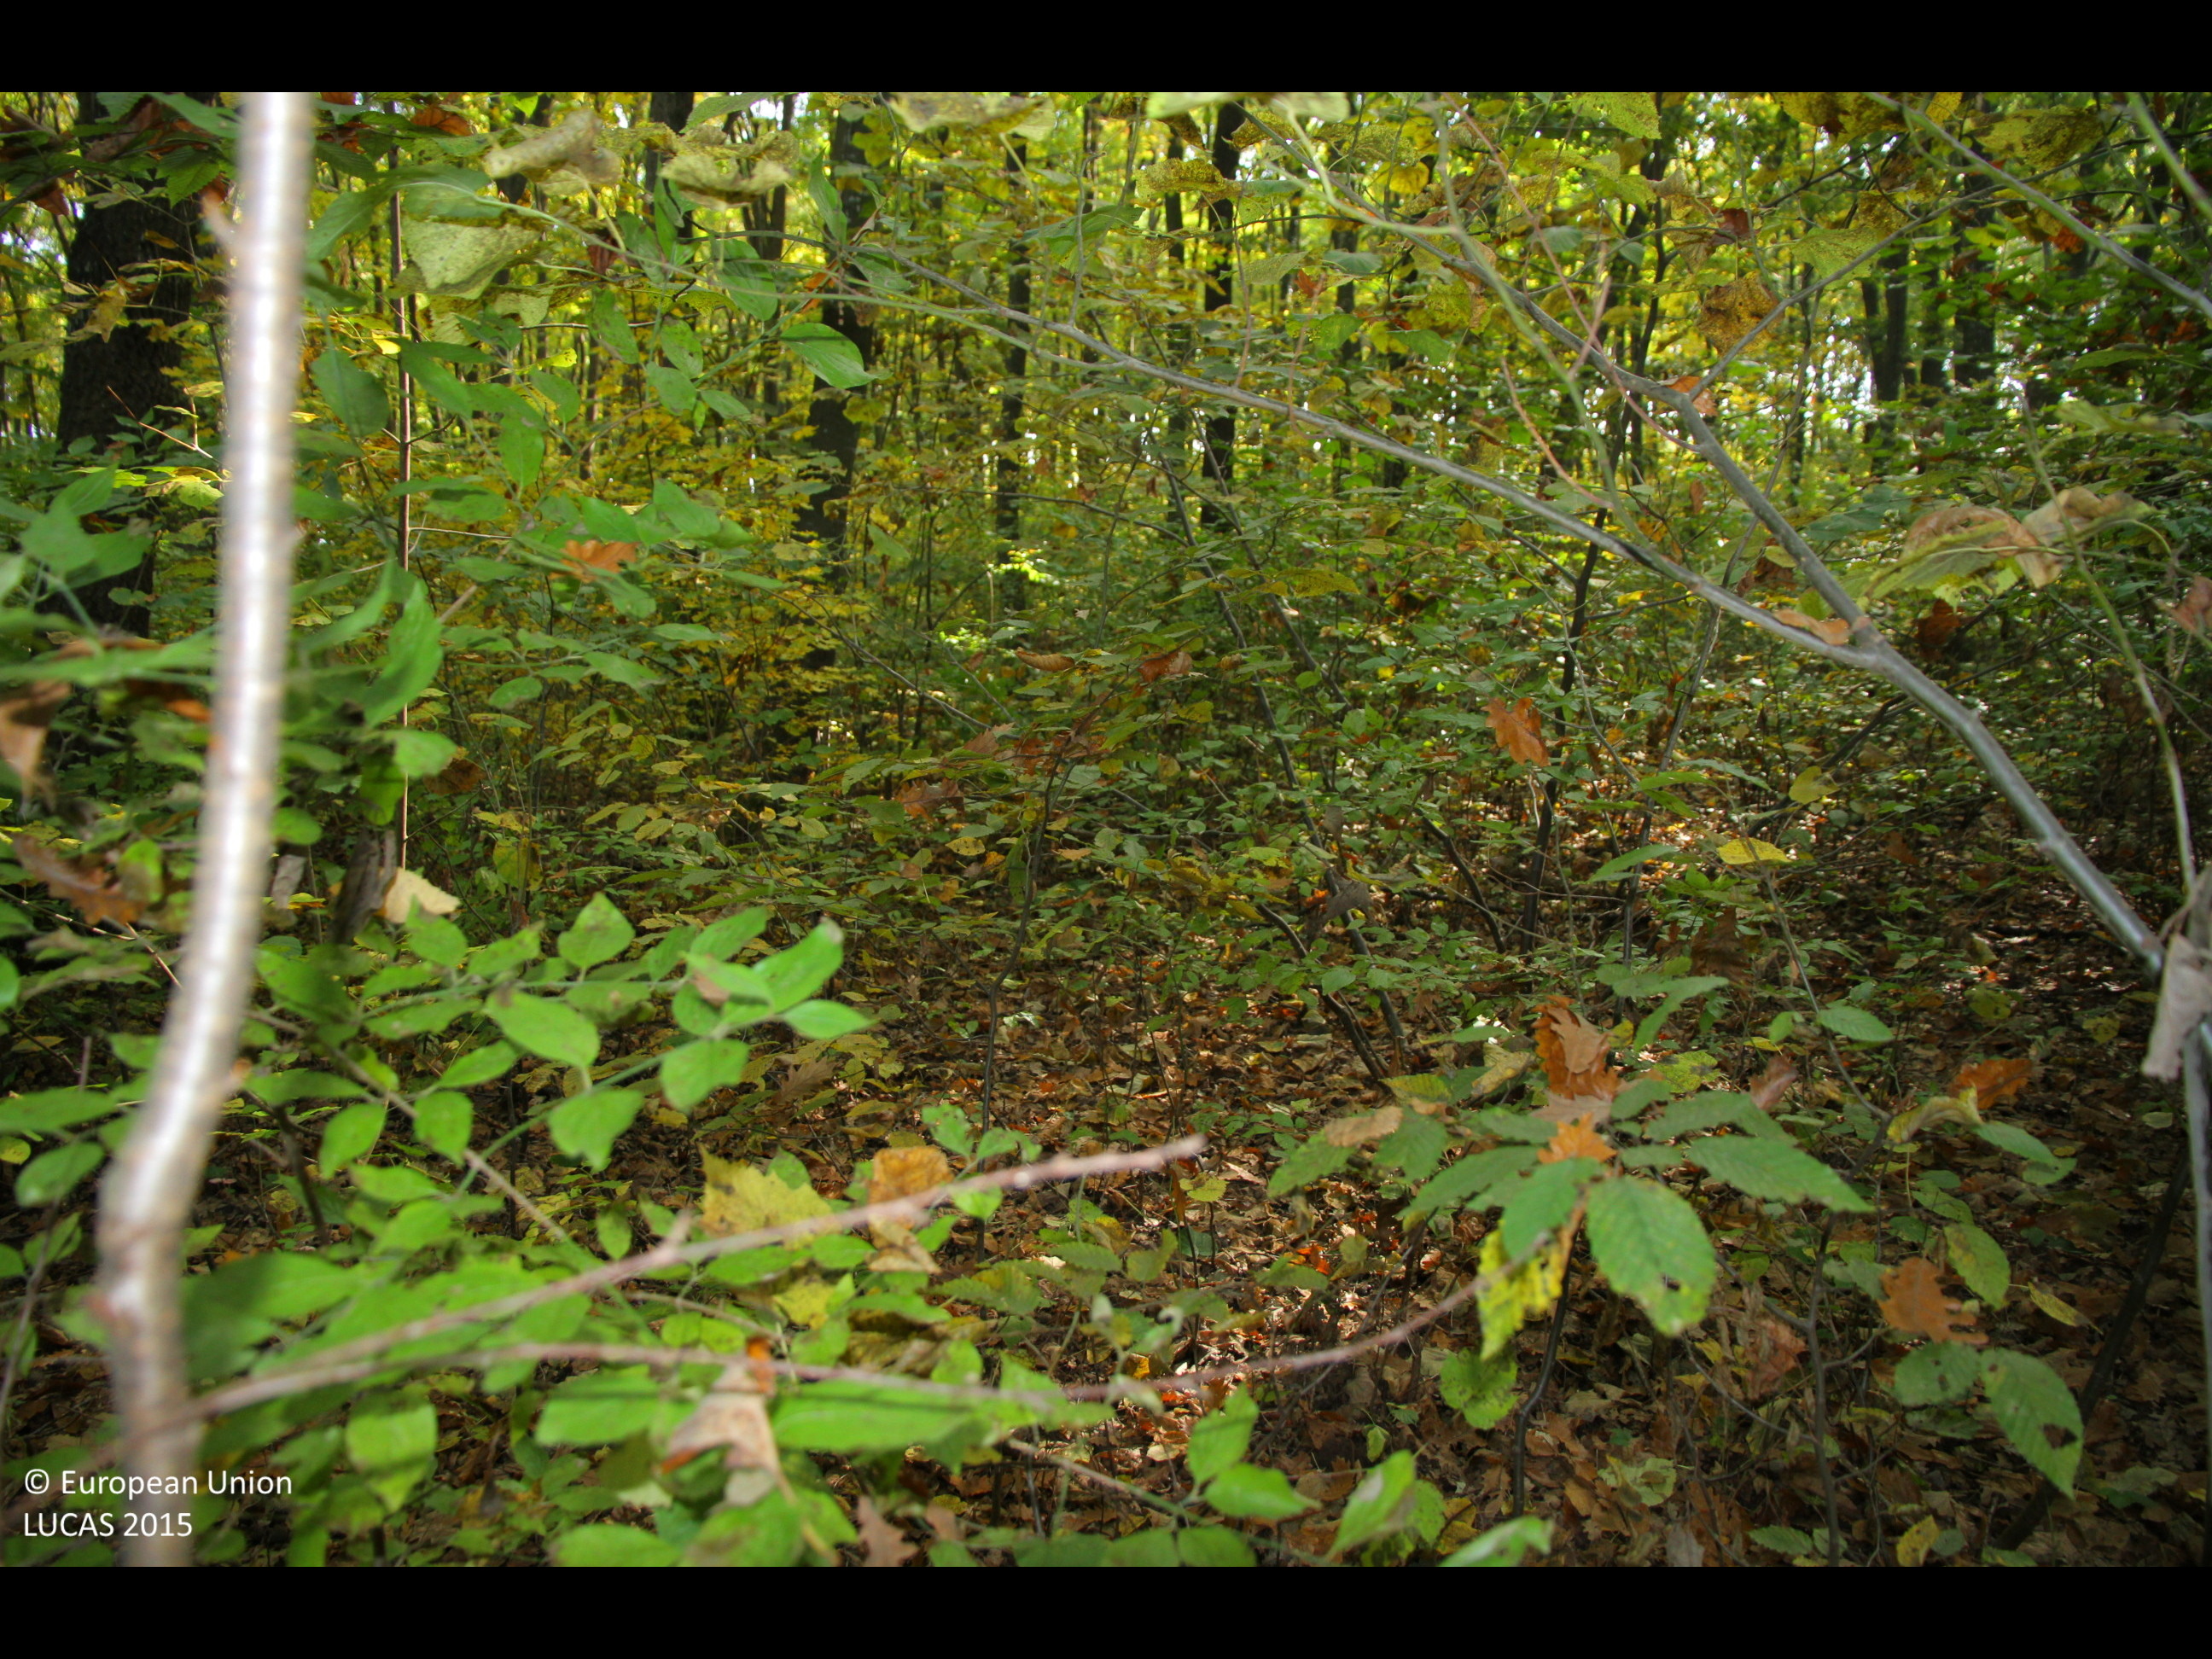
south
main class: Woodland
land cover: Broadleaved woodland
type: mesophytic deciduous forest
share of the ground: > 75 %
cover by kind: broadleaved forest trees 100 %
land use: Forestry
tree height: > 5 m
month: October
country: BG
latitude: 43.1726
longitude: 26.9020
